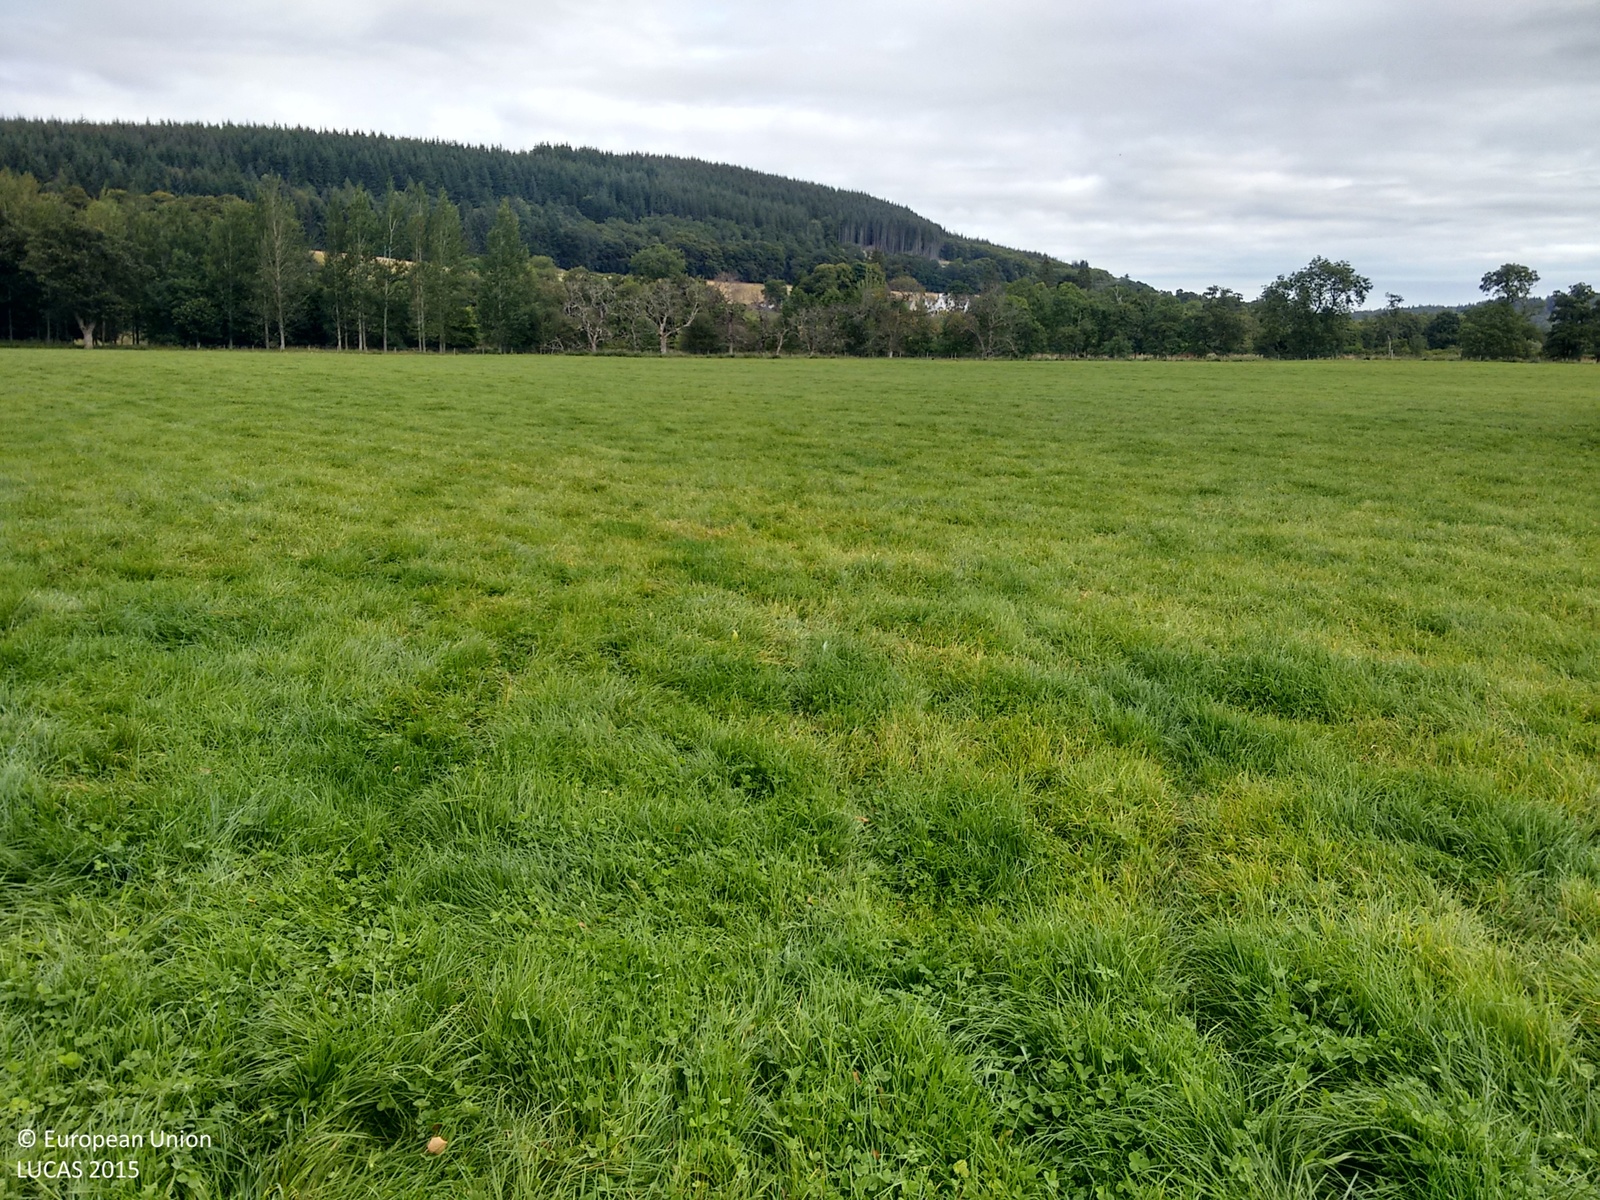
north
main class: Woodland
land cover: Broadleaved woodland
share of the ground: > 75 %
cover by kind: herbaceous plants 65 %, broadleaved forest trees 35 %
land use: Agriculture (excluding fallow land and kitchen gardens)
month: September
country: GB
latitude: 57.4193
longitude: -3.3721
